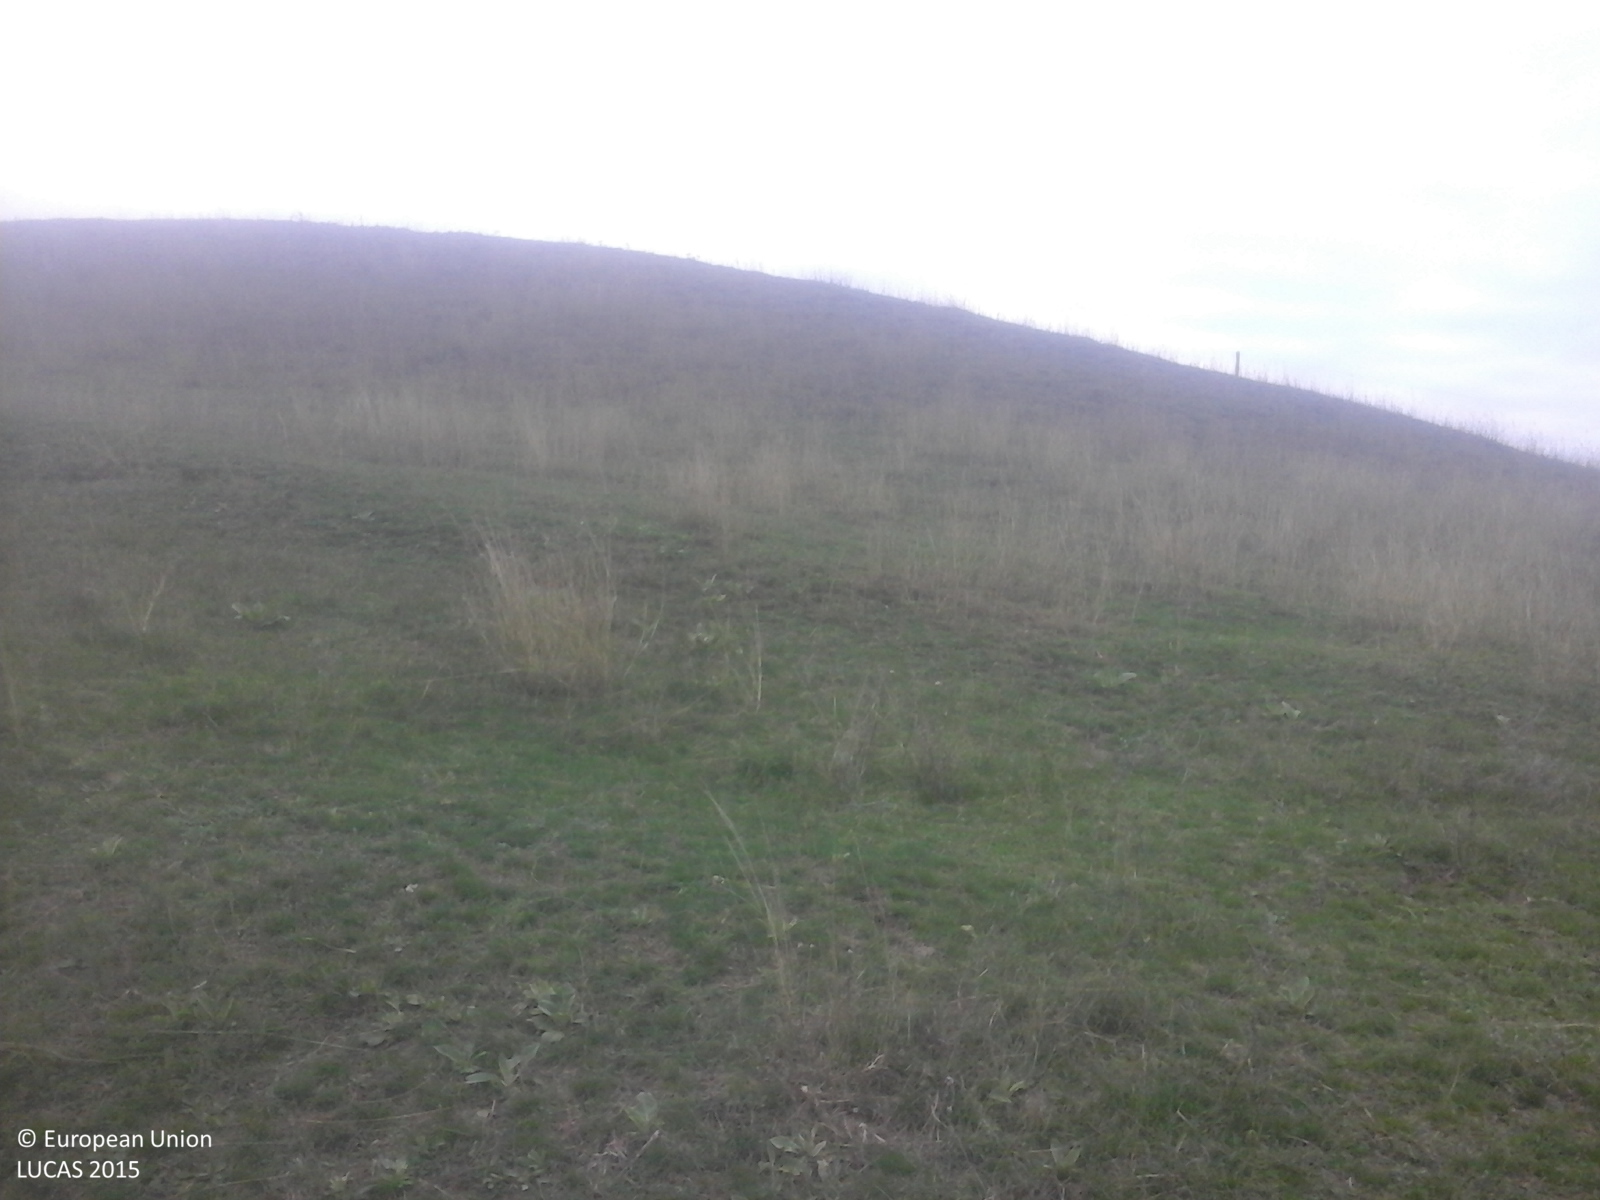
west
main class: Grassland
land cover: Grassland without tree/shrub cover
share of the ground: > 75 %
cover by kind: herbaceous plants 100 %
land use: Agriculture (excluding fallow land and kitchen gardens)
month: September
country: RO
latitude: 45.9150
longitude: 23.7474
